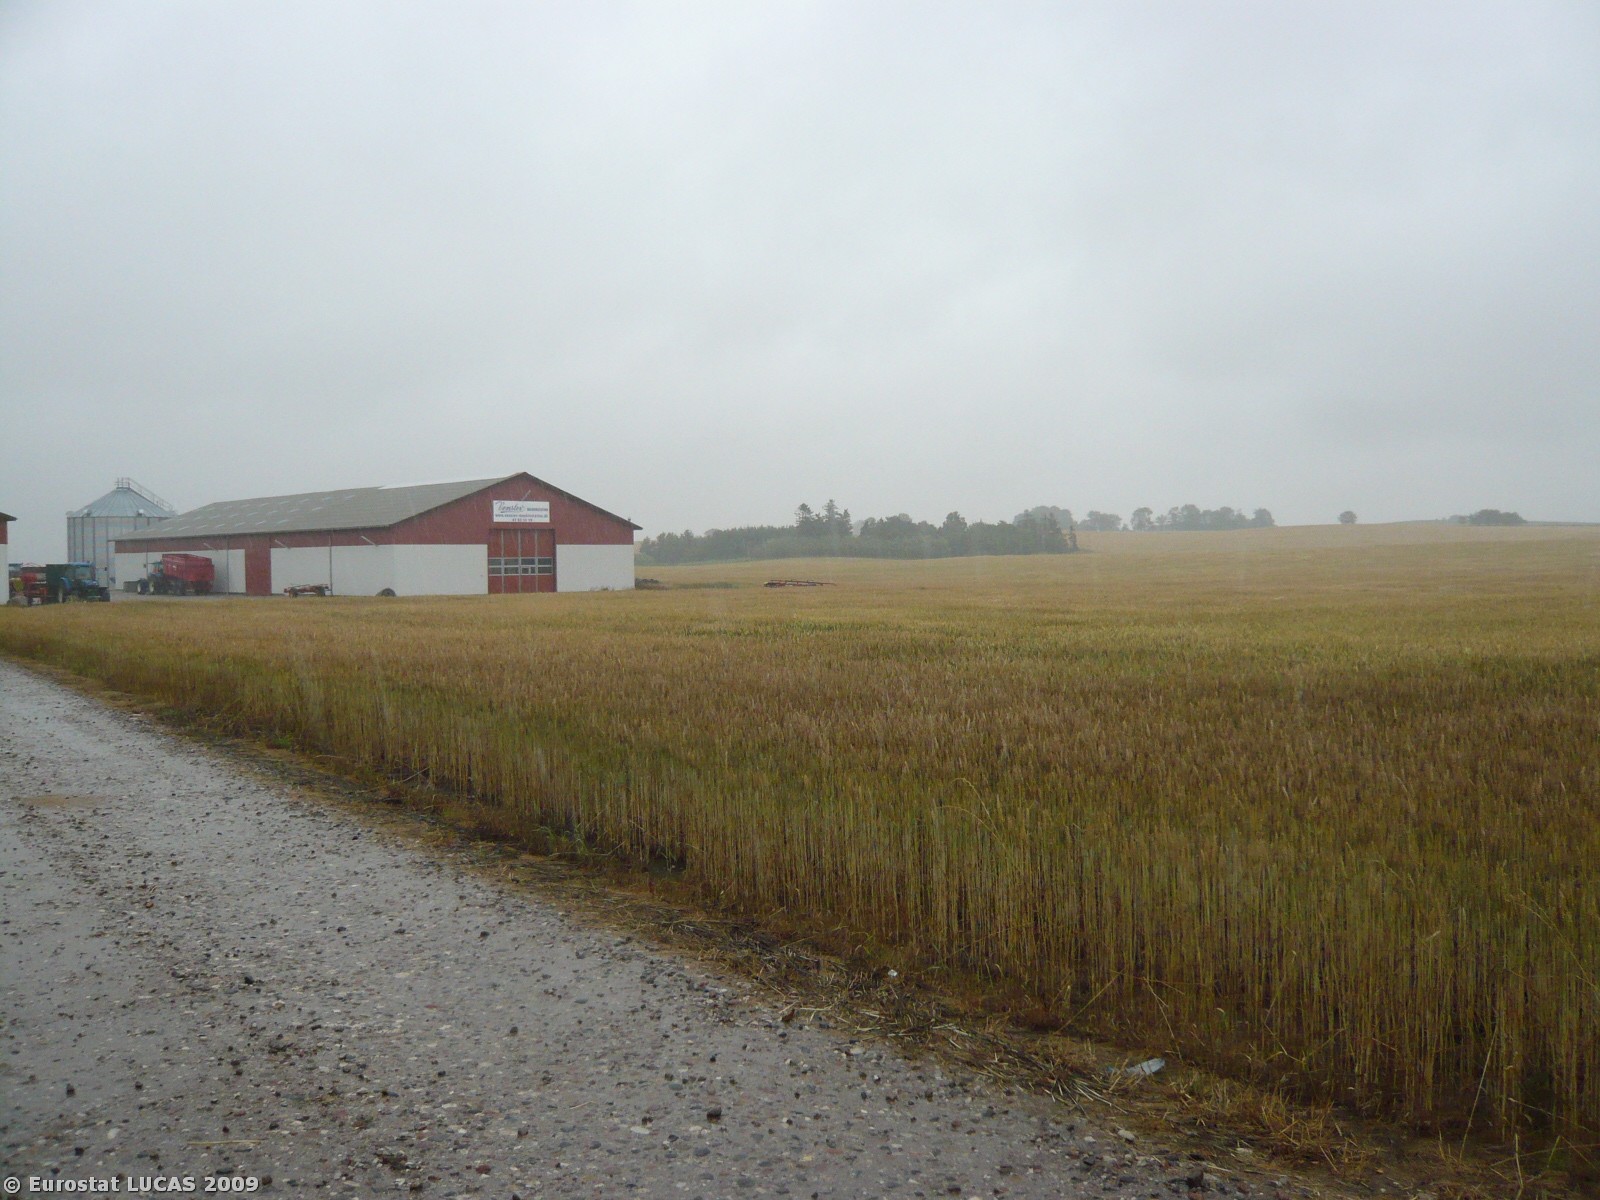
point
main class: Cropland
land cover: Common wheat
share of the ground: > 75 %
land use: Agriculture (excluding fallow land and kitchen gardens)
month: July
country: DK
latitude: 55.7957
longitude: 11.9282
